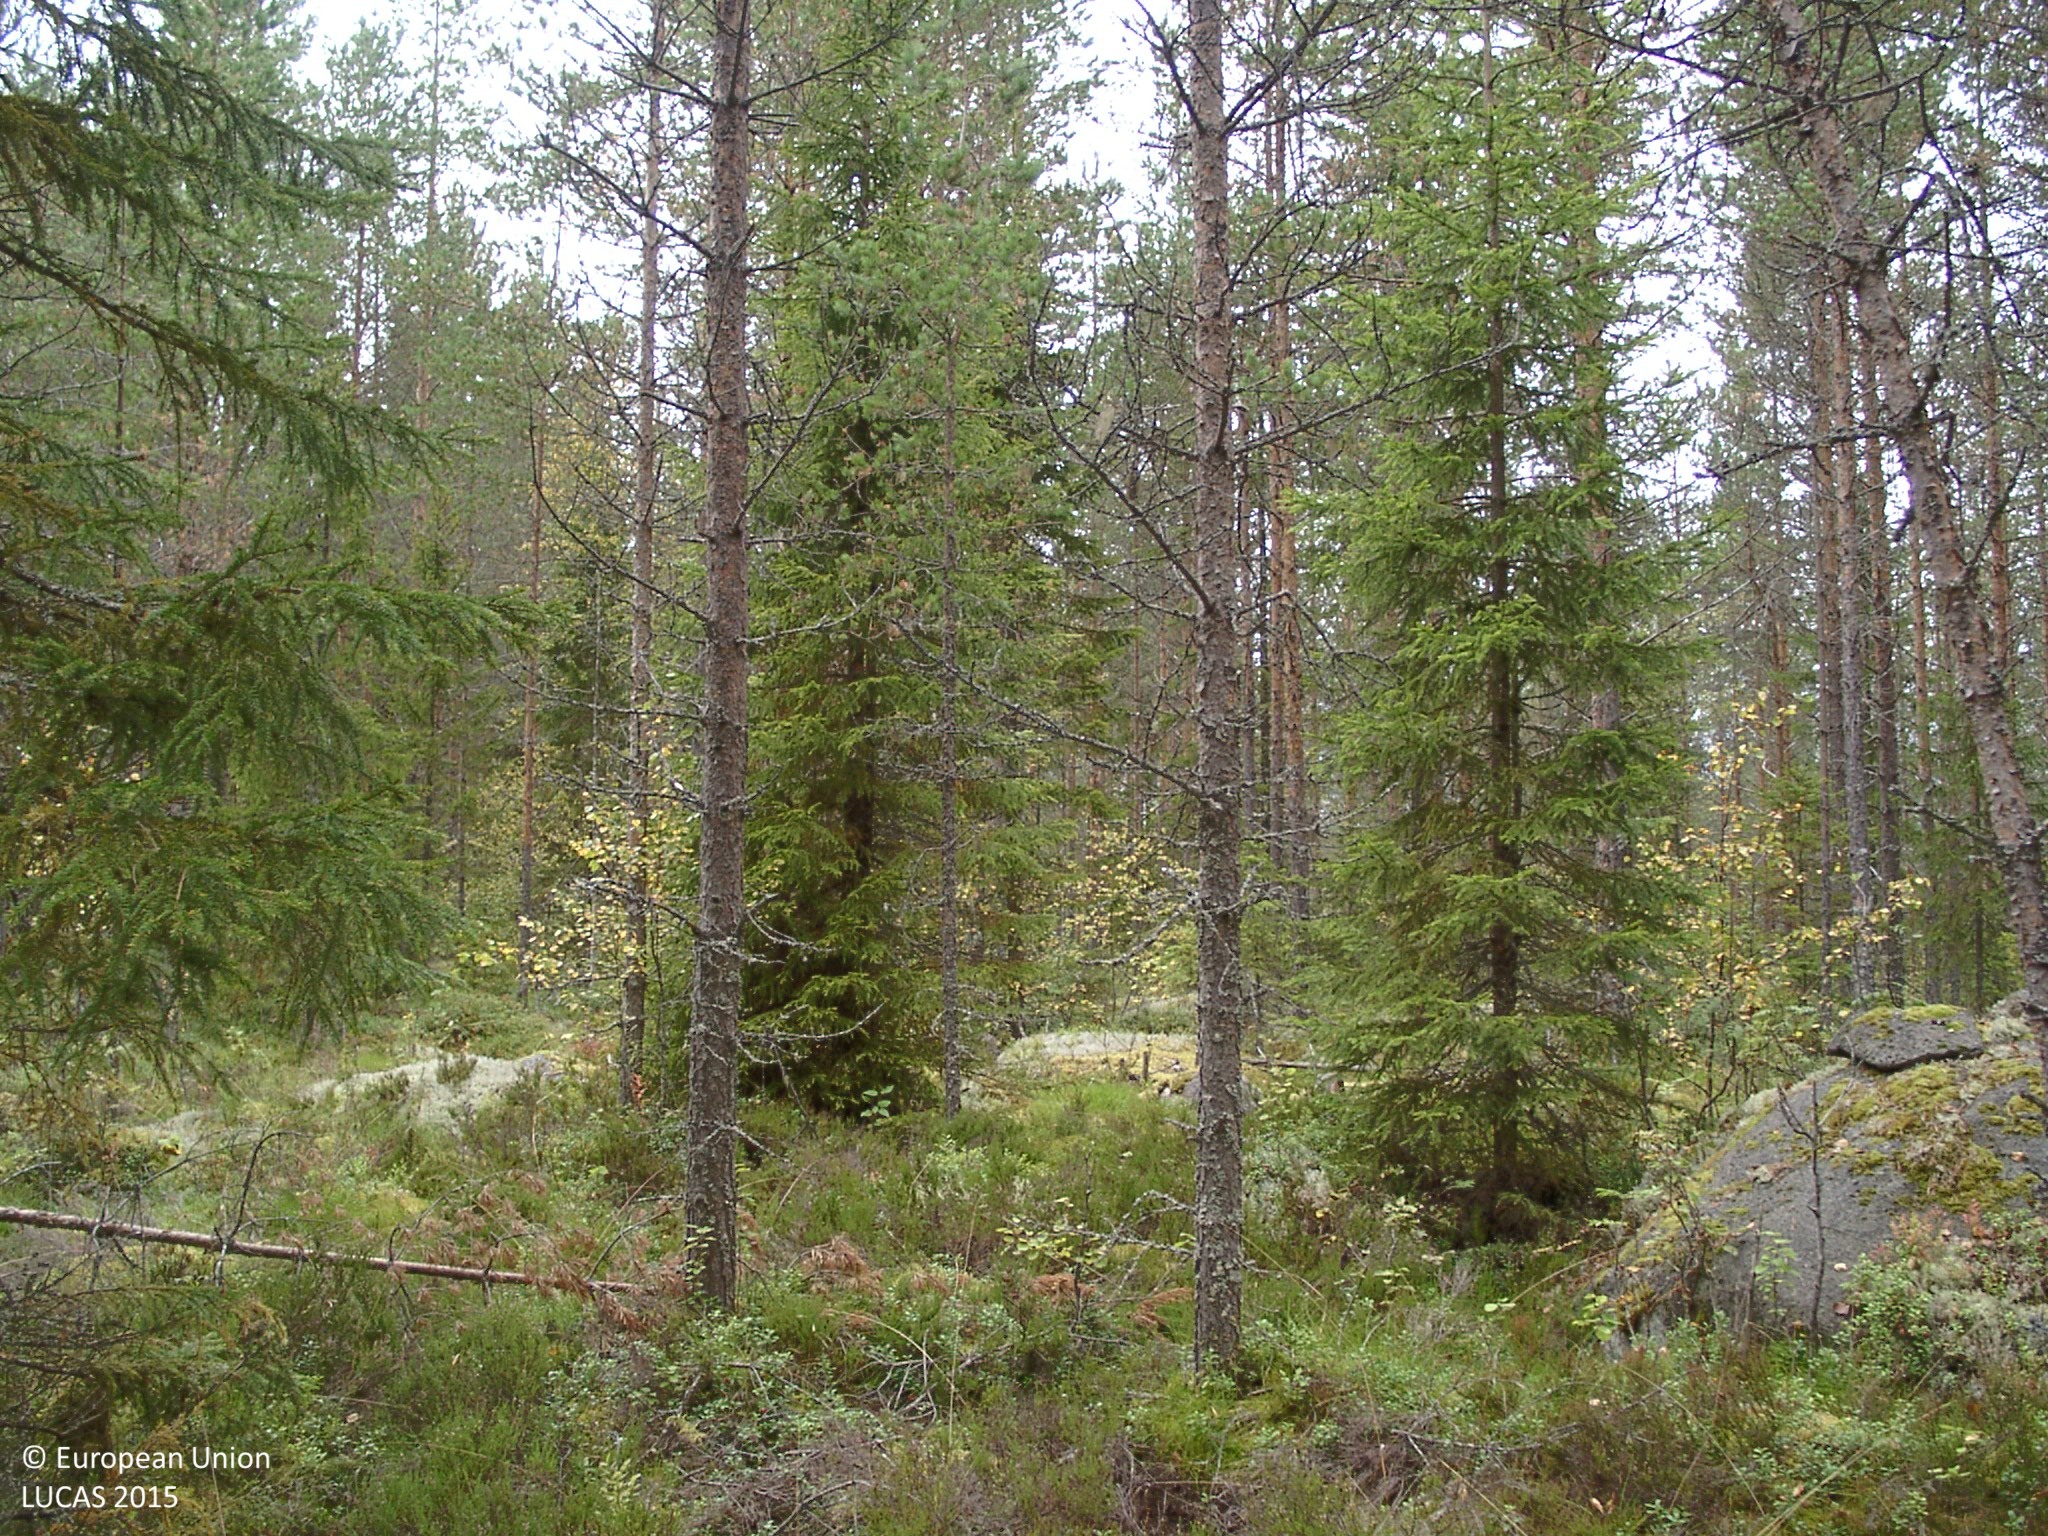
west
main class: Woodland
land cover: Pine dominated coniferous woodland
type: boreal forest
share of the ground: 50 - 75 %
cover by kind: coniferous forest trees 50 %, shrubs 20 %, lichens and mosses 20 %, broadleaved forest trees 10 %
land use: Forestry
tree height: > 5 m
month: September
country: FI
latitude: 62.8706
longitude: 25.3383
